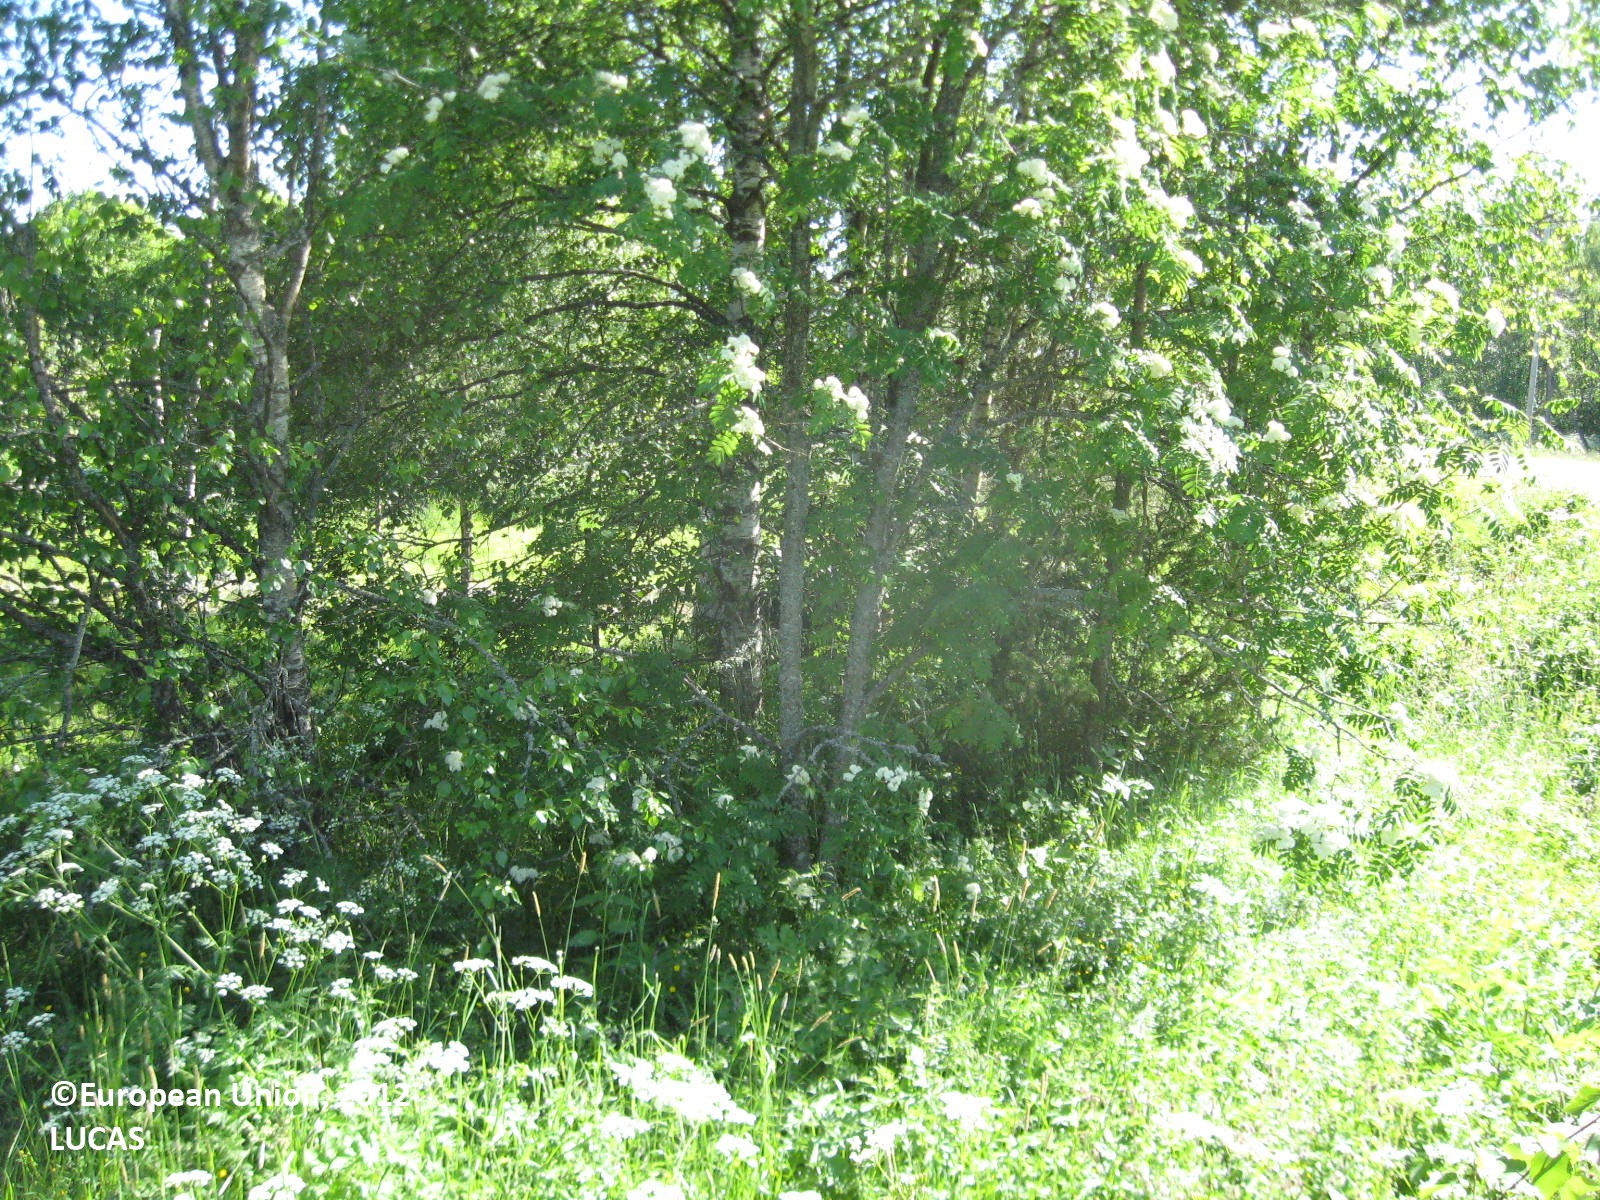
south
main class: Grassland
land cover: Grassland without tree/shrub cover
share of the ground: 10 - 25 %
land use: Agriculture (excluding fallow land and kitchen gardens)
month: June
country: FI
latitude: 62.7785
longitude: 21.6631
